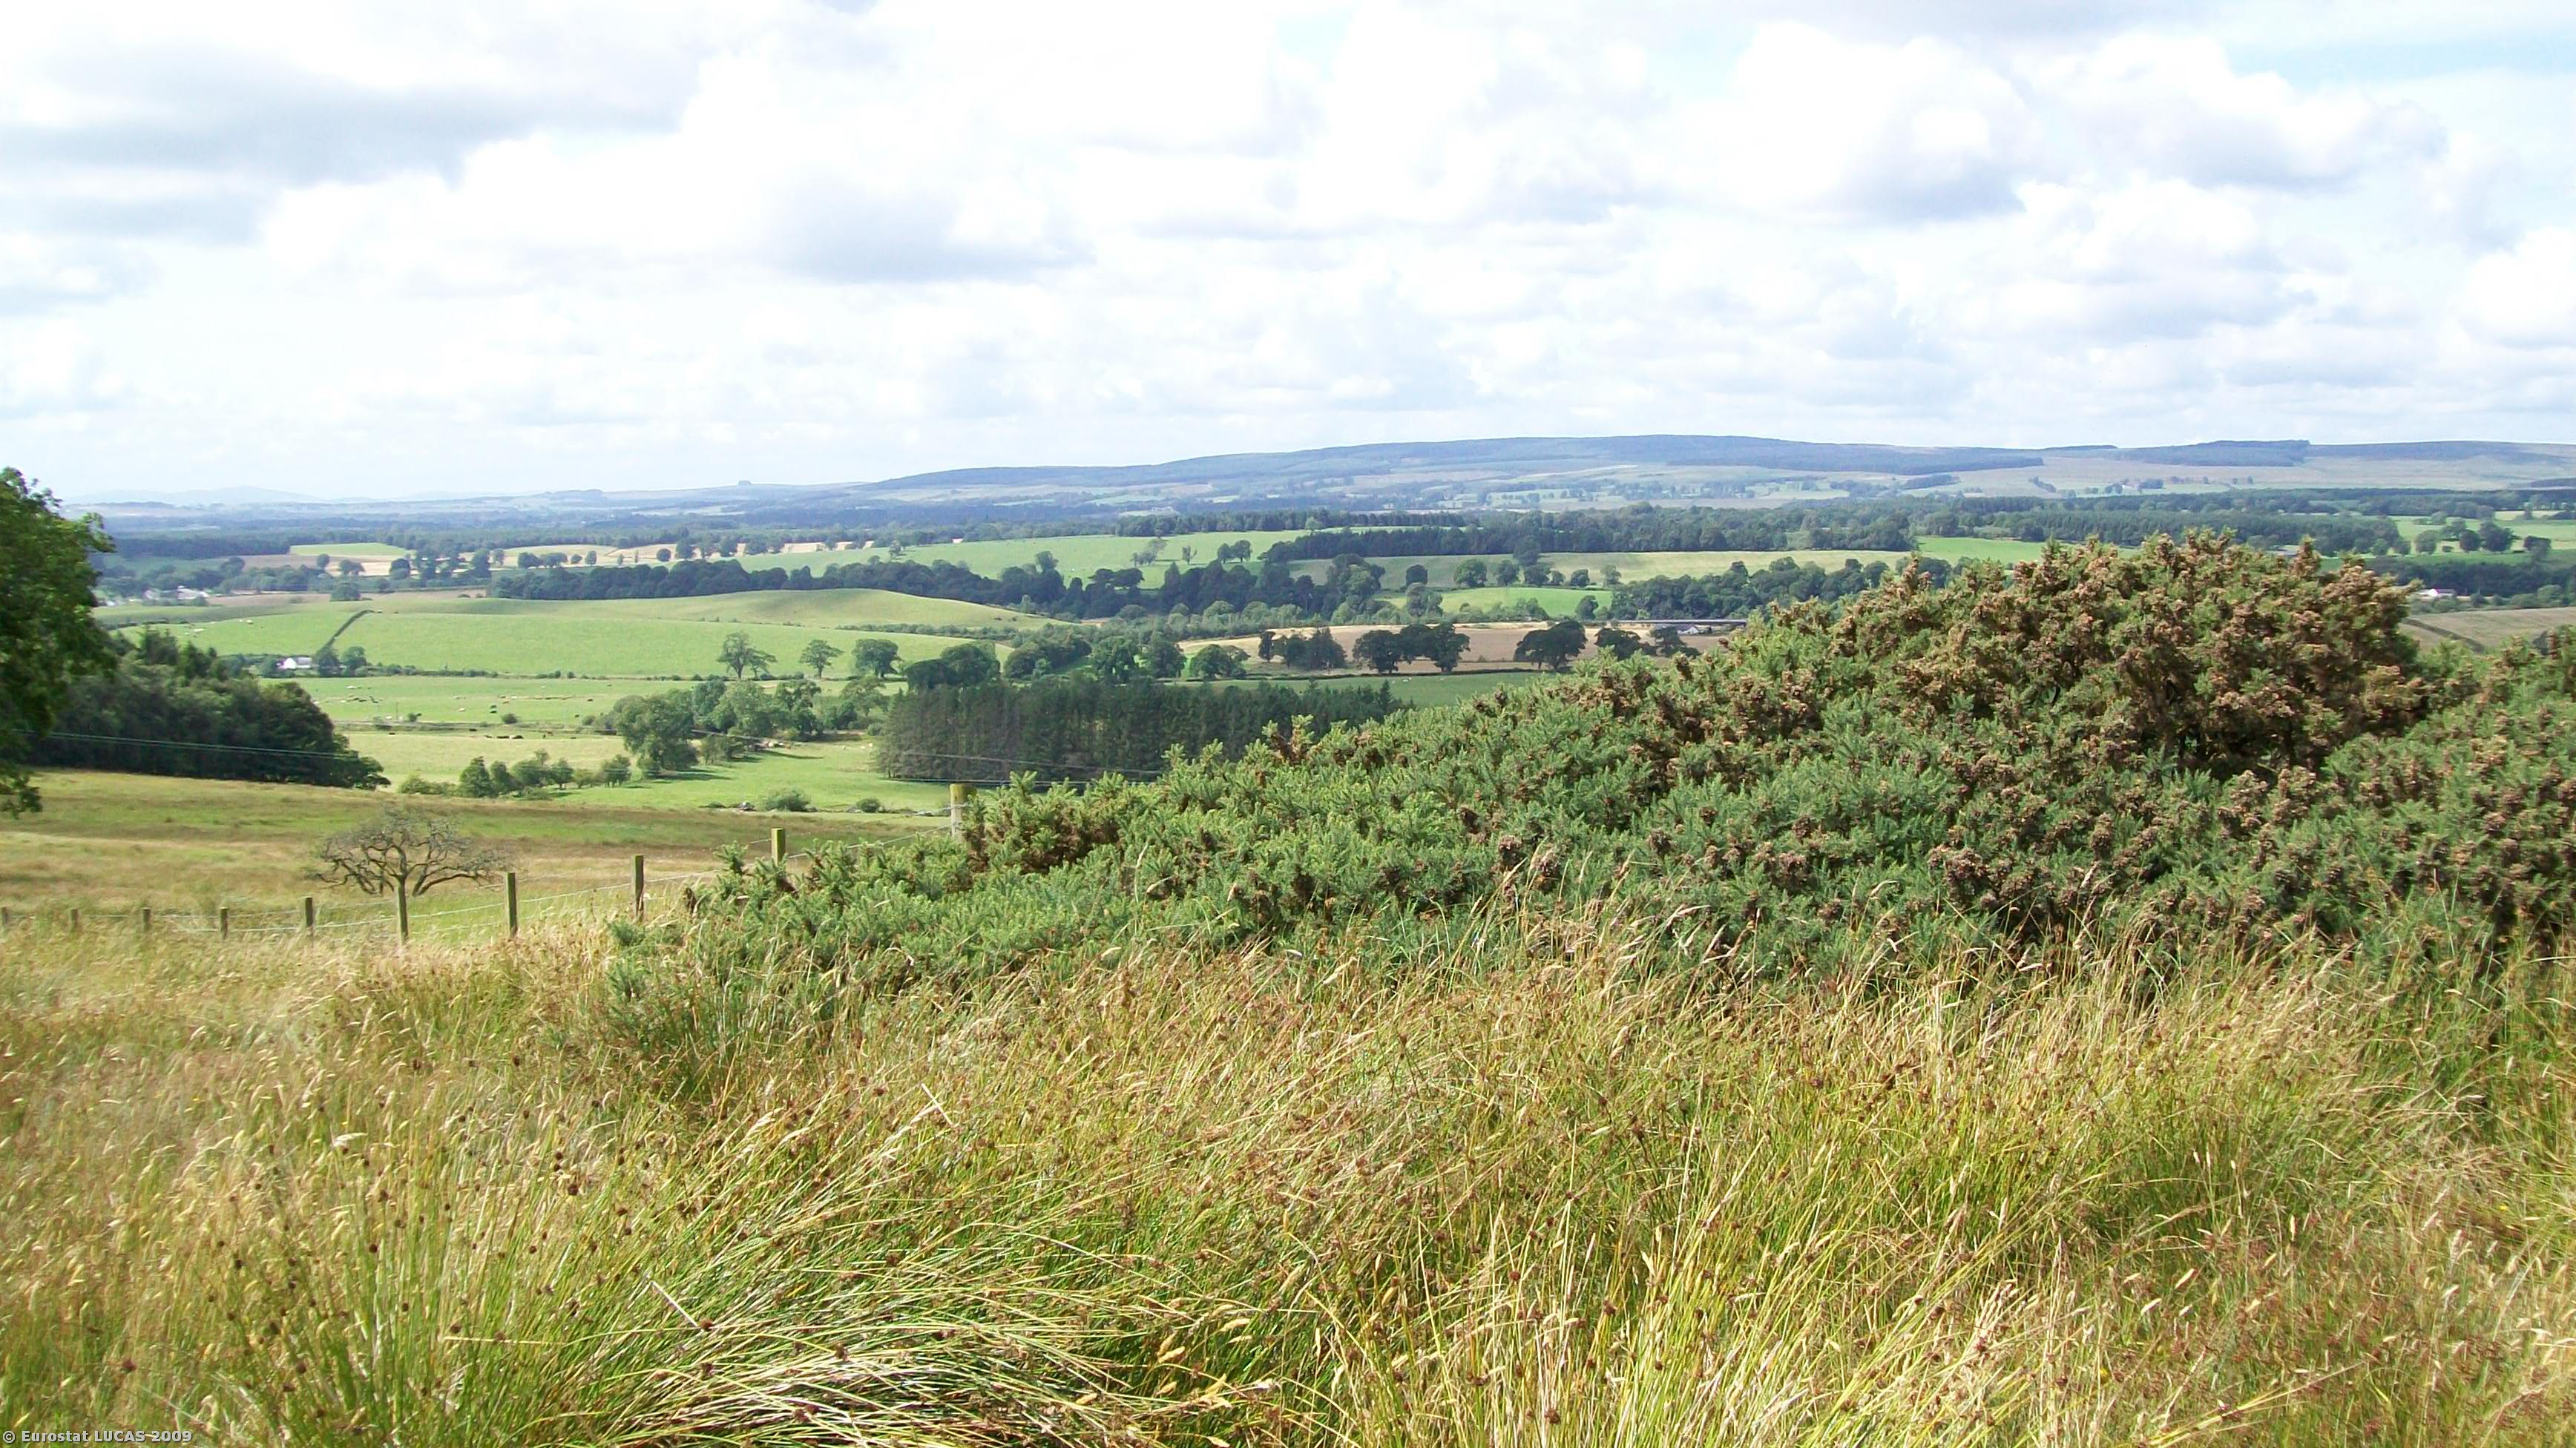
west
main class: Grassland
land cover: Grassland without tree/shrub cover
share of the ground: > 75 %
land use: Agriculture (excluding fallow land and kitchen gardens)
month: August
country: GB
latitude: 55.2082
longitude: -3.3880
